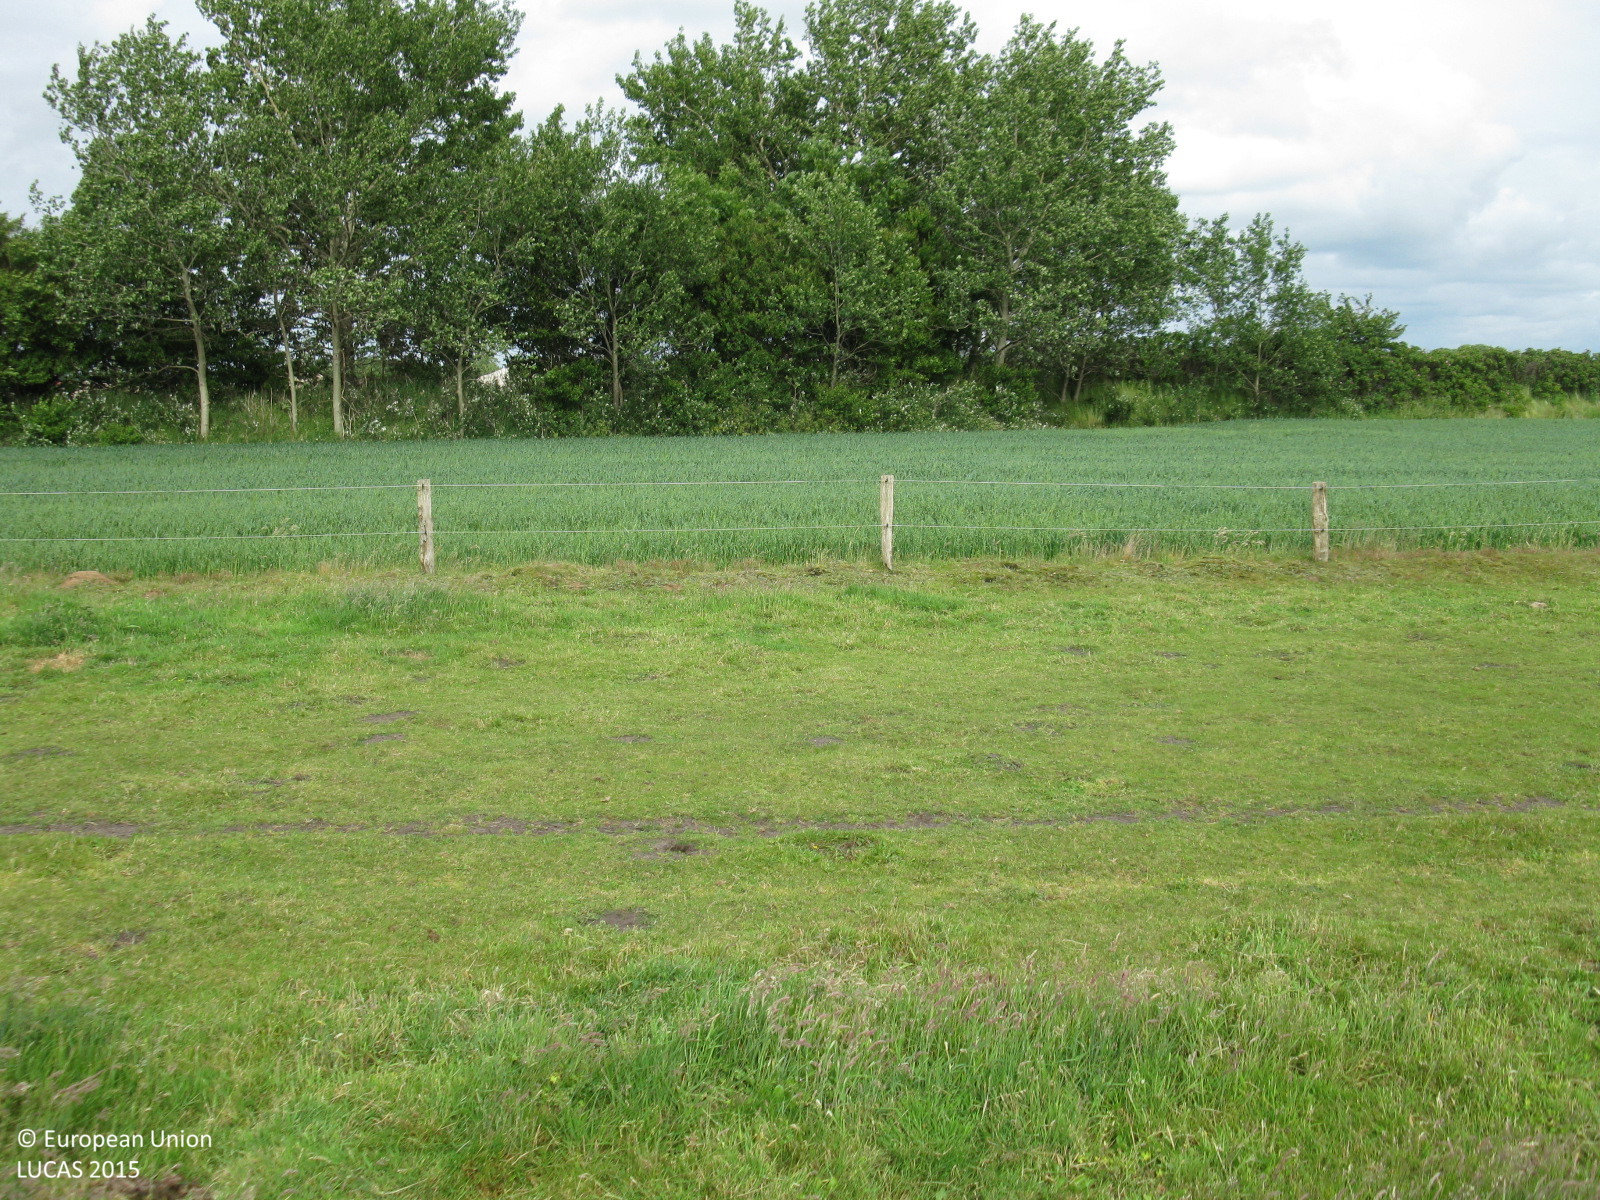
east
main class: Grassland
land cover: Grassland without tree/shrub cover
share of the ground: > 75 %
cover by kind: herbaceous plants 100 %
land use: Agriculture (excluding fallow land and kitchen gardens)
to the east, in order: Grassland without tree/shrub cover; Fences; Oats; Broadleaved woodland; Tracks; Spontaneously vegetated surfaces; Sand; Inland fresh water bodies
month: June
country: DE
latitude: 53.6069
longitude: 7.3558
